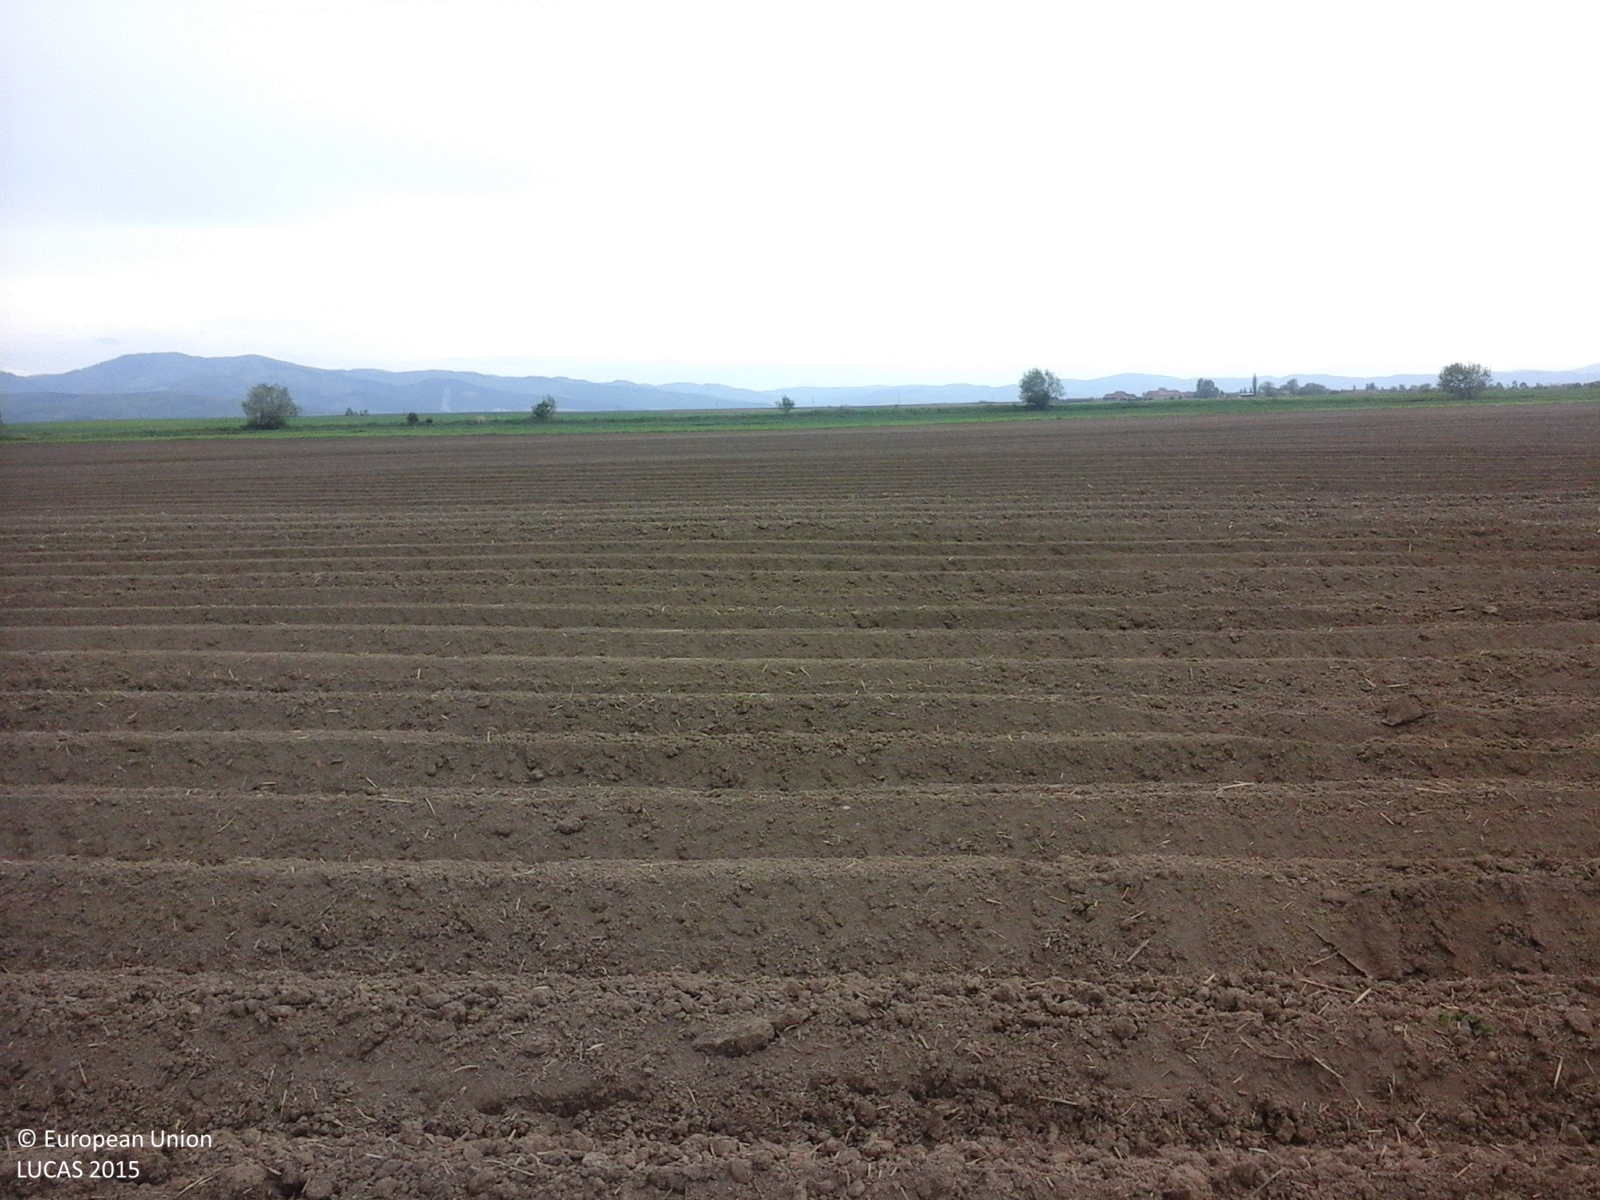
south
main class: Cropland
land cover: Potatoes
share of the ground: < 10 %
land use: Agriculture (excluding fallow land and kitchen gardens)
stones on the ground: < 10 %
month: May
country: RO
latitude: 45.9391
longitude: 26.1530
